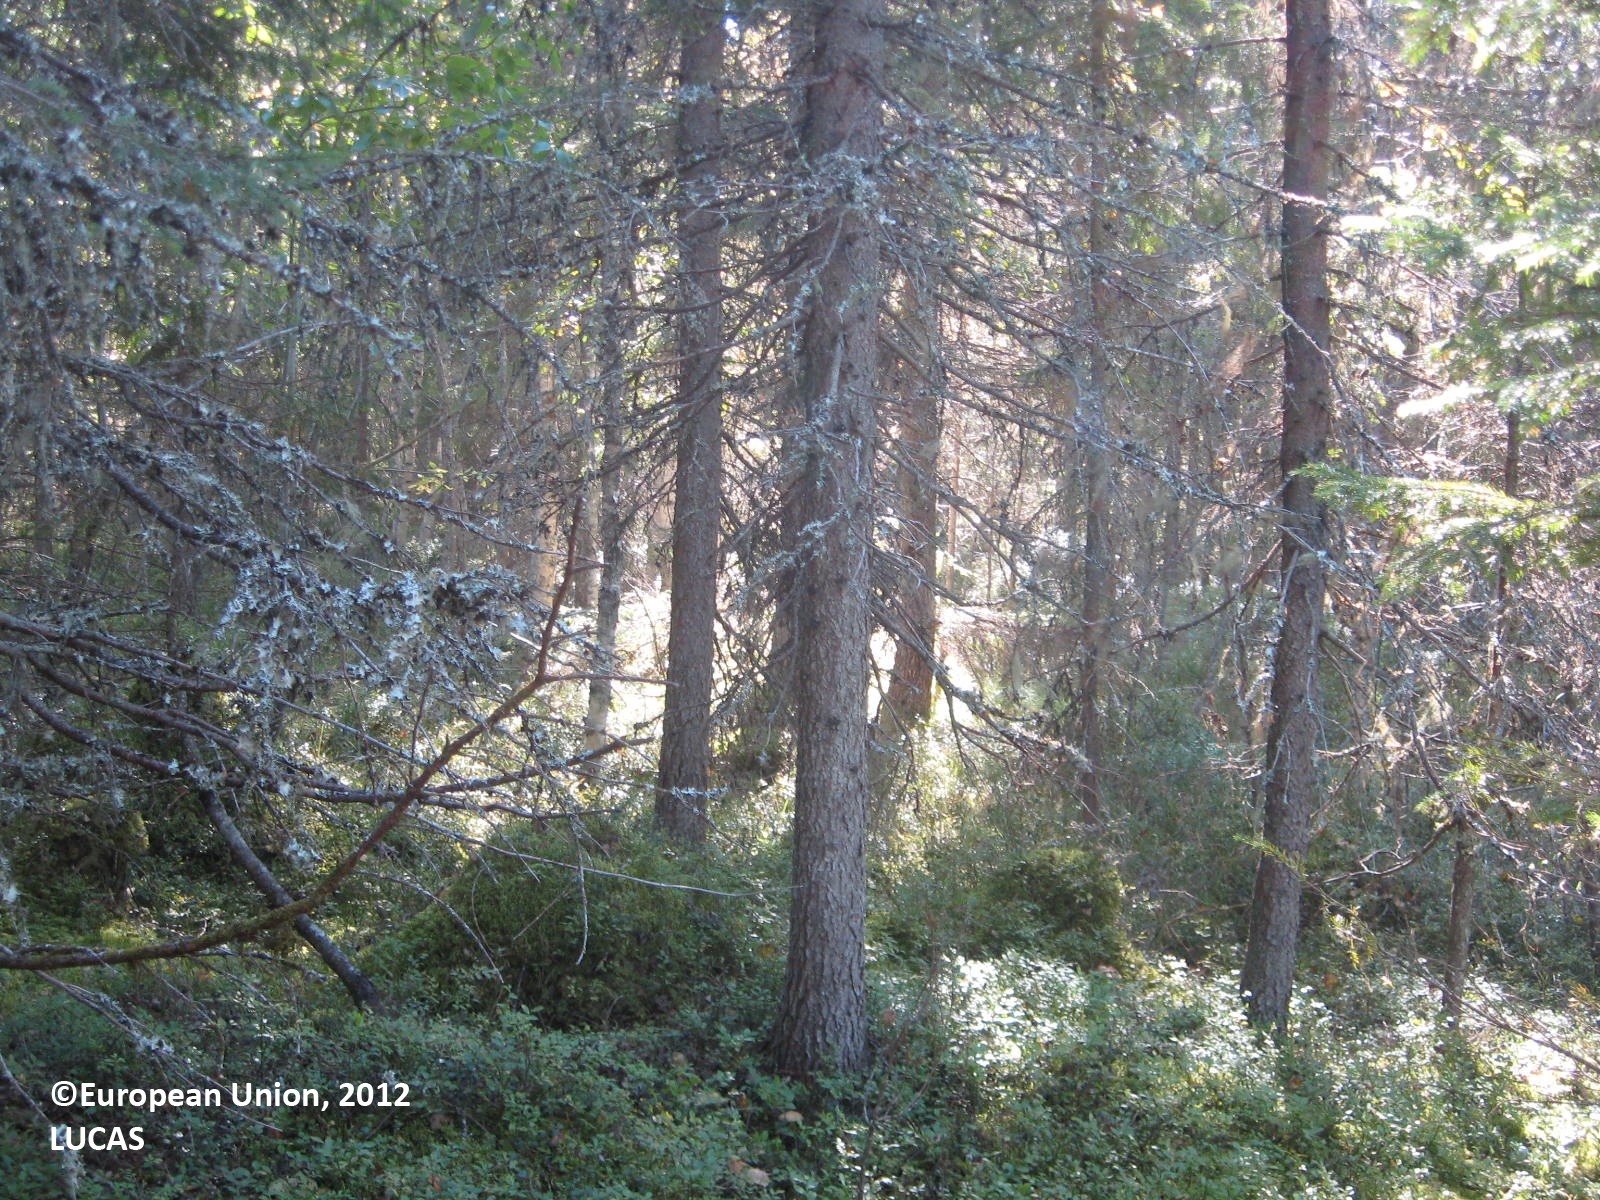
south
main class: Woodland
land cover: Spruce dominated coniferous woodland
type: boreal forest
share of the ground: > 75 %
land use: Forestry
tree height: > 5 m
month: August
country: FI
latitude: 63.7984
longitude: 29.4026
